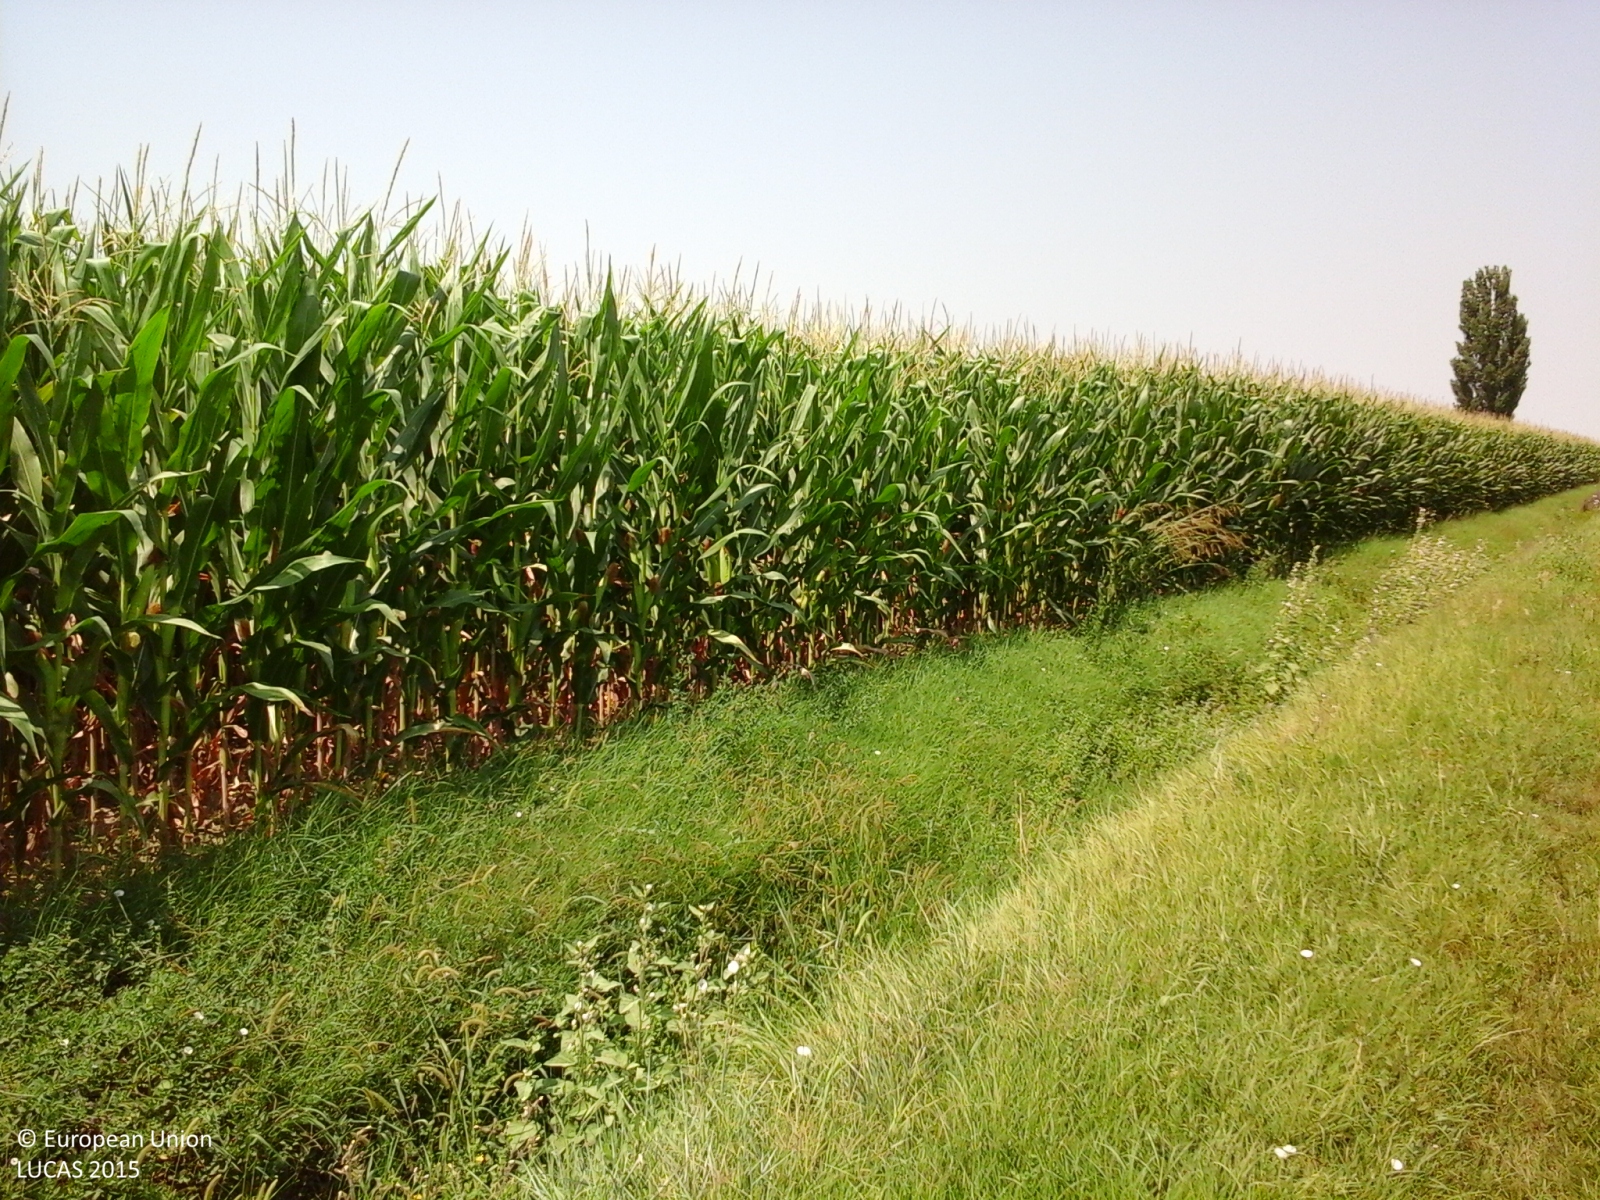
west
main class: Cropland
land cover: Maize
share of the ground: > 75 %
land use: Agriculture (excluding fallow land and kitchen gardens)
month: July
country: IT
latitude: 44.6261
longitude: 11.6477
